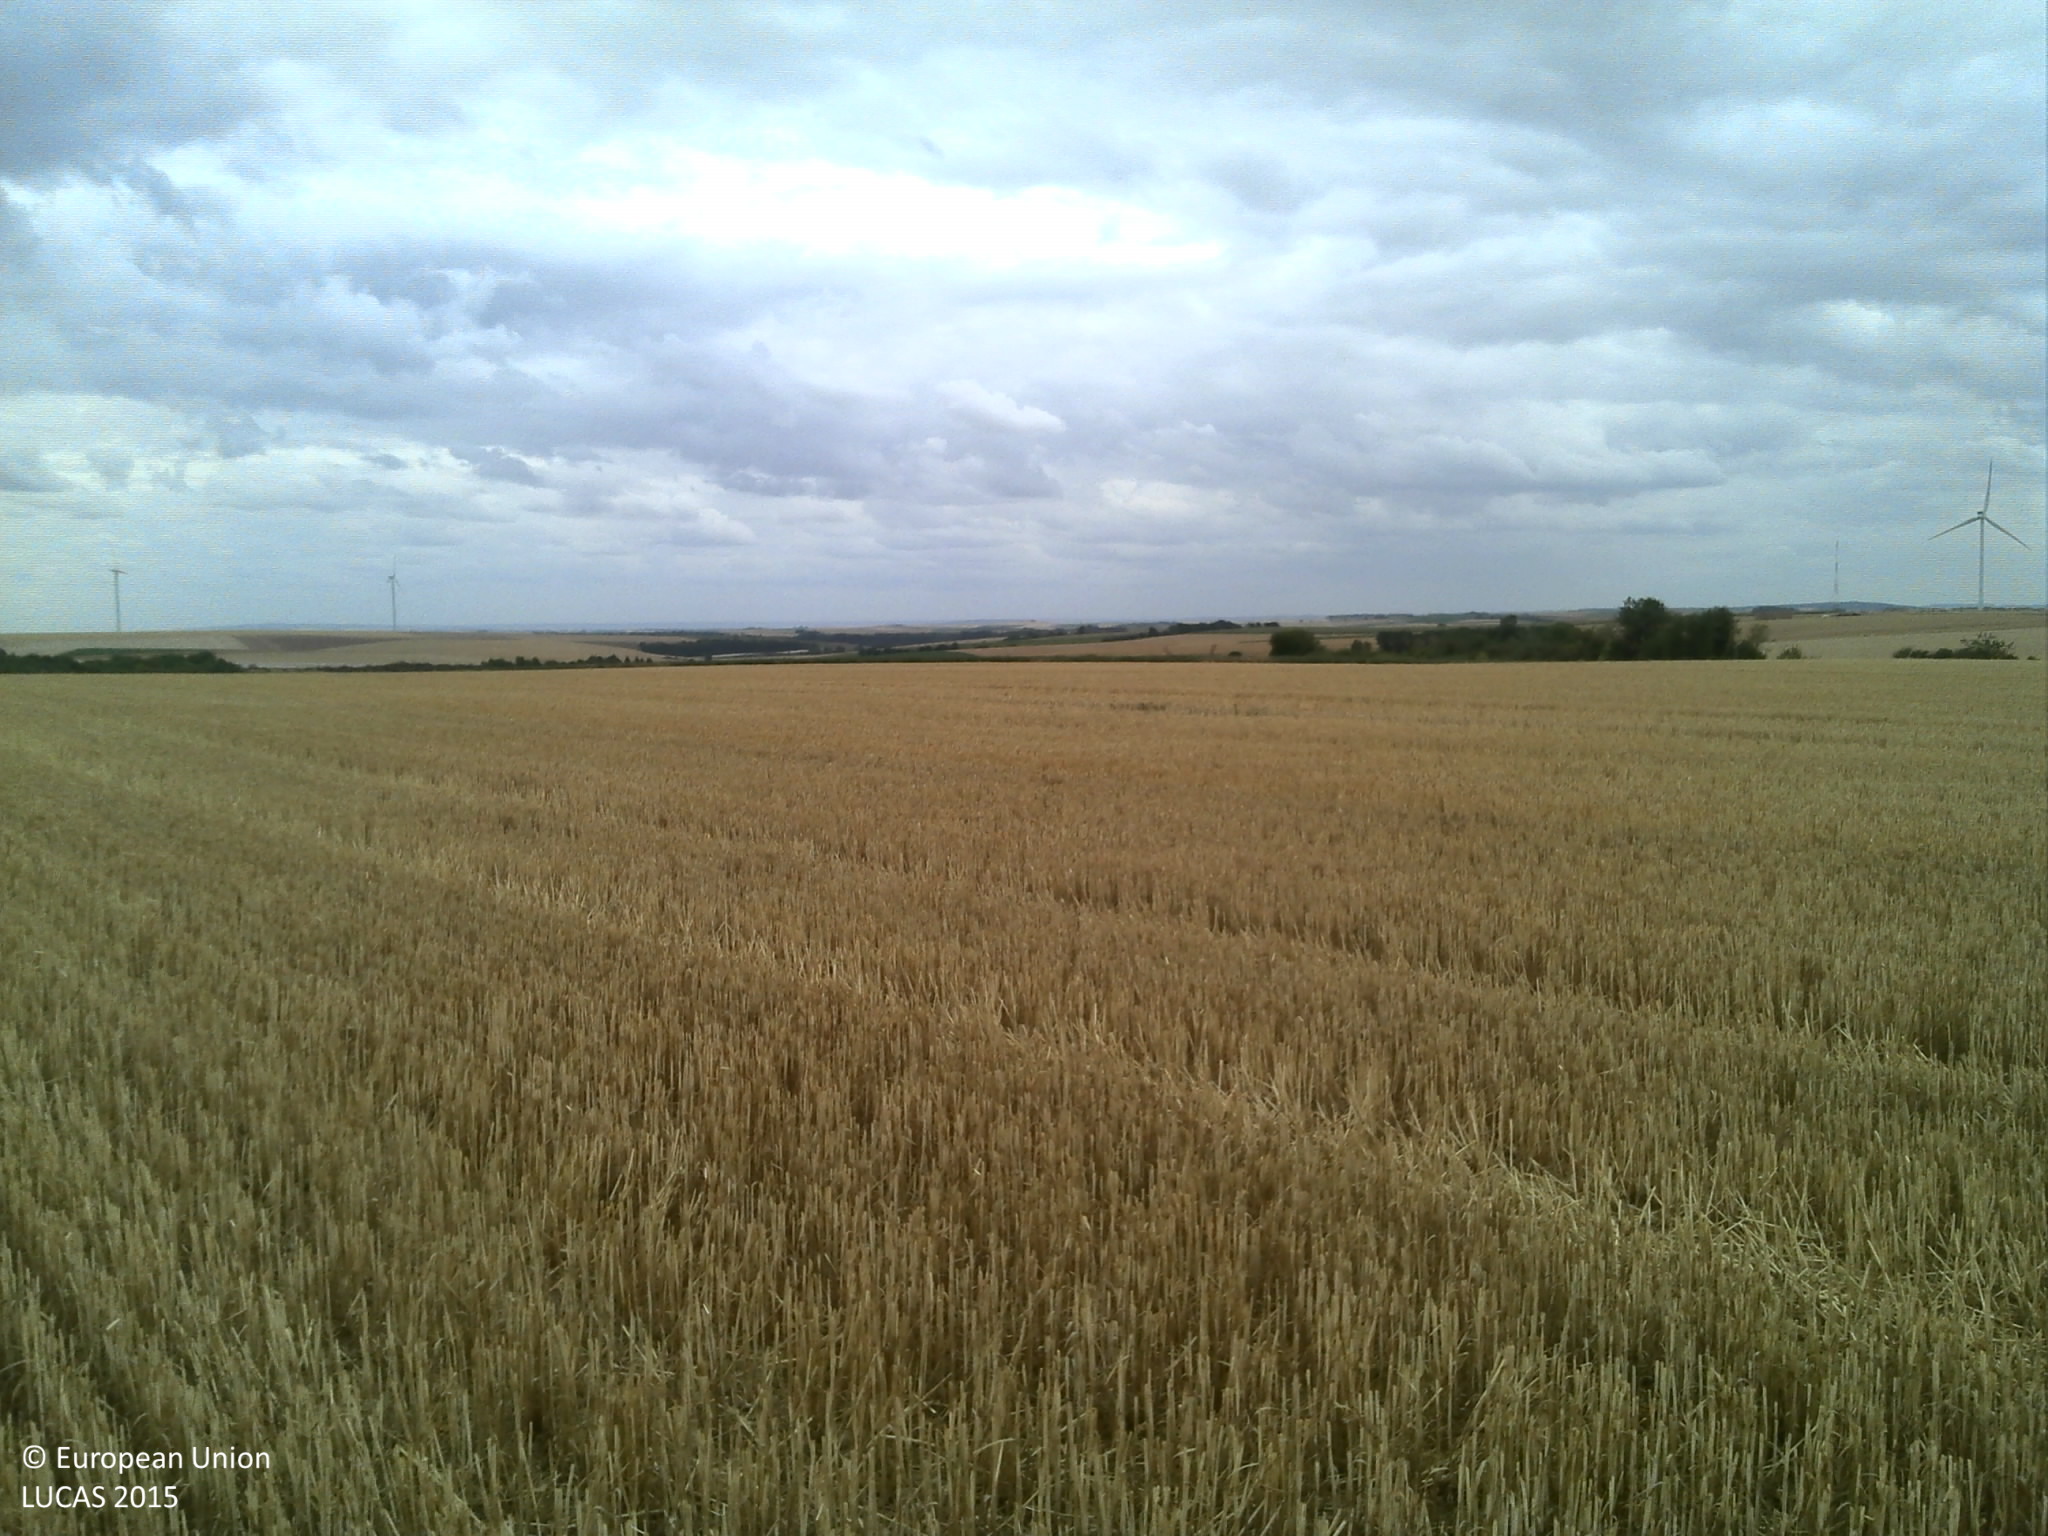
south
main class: Cropland
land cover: Common wheat
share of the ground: 50 - 75 %
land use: Agriculture (excluding fallow land and kitchen gardens)
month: July
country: FR
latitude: 49.5637
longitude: 4.1190
